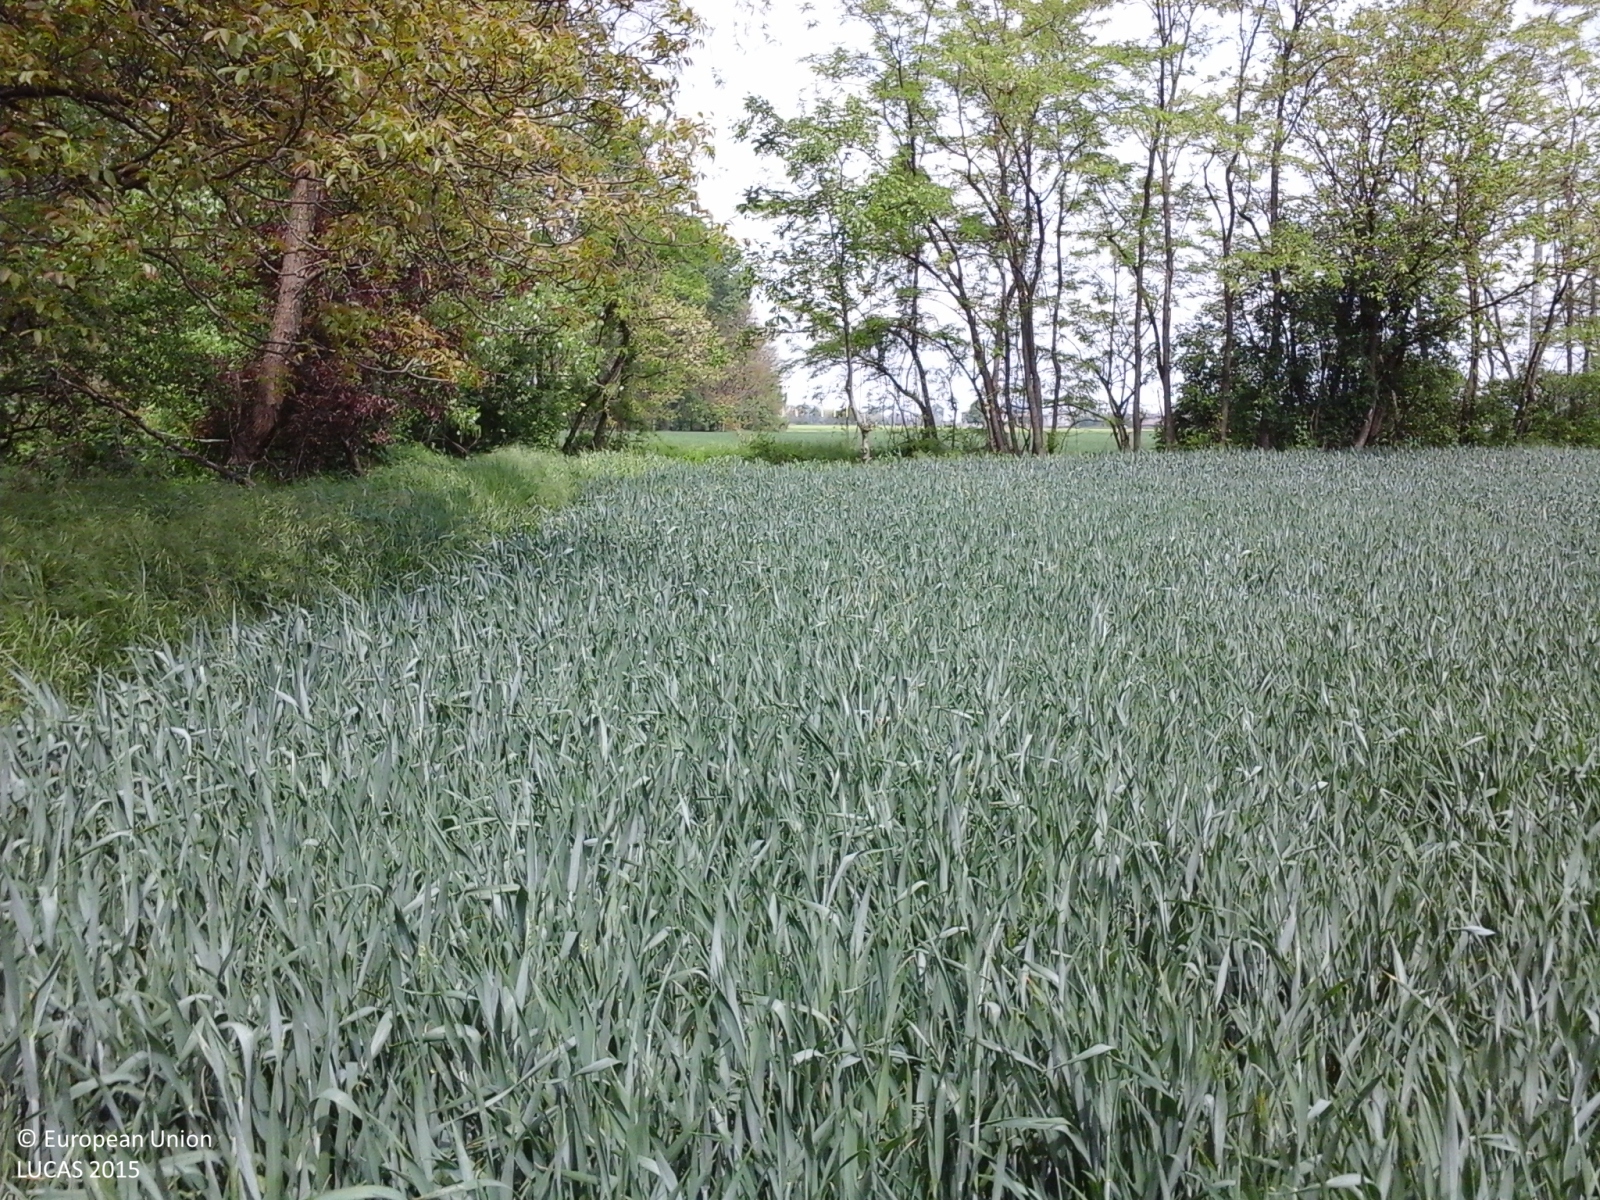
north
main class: Cropland
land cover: Common wheat
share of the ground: > 75 %
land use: Agriculture (excluding fallow land and kitchen gardens)
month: April
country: IT
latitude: 45.0528
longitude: 9.5564
